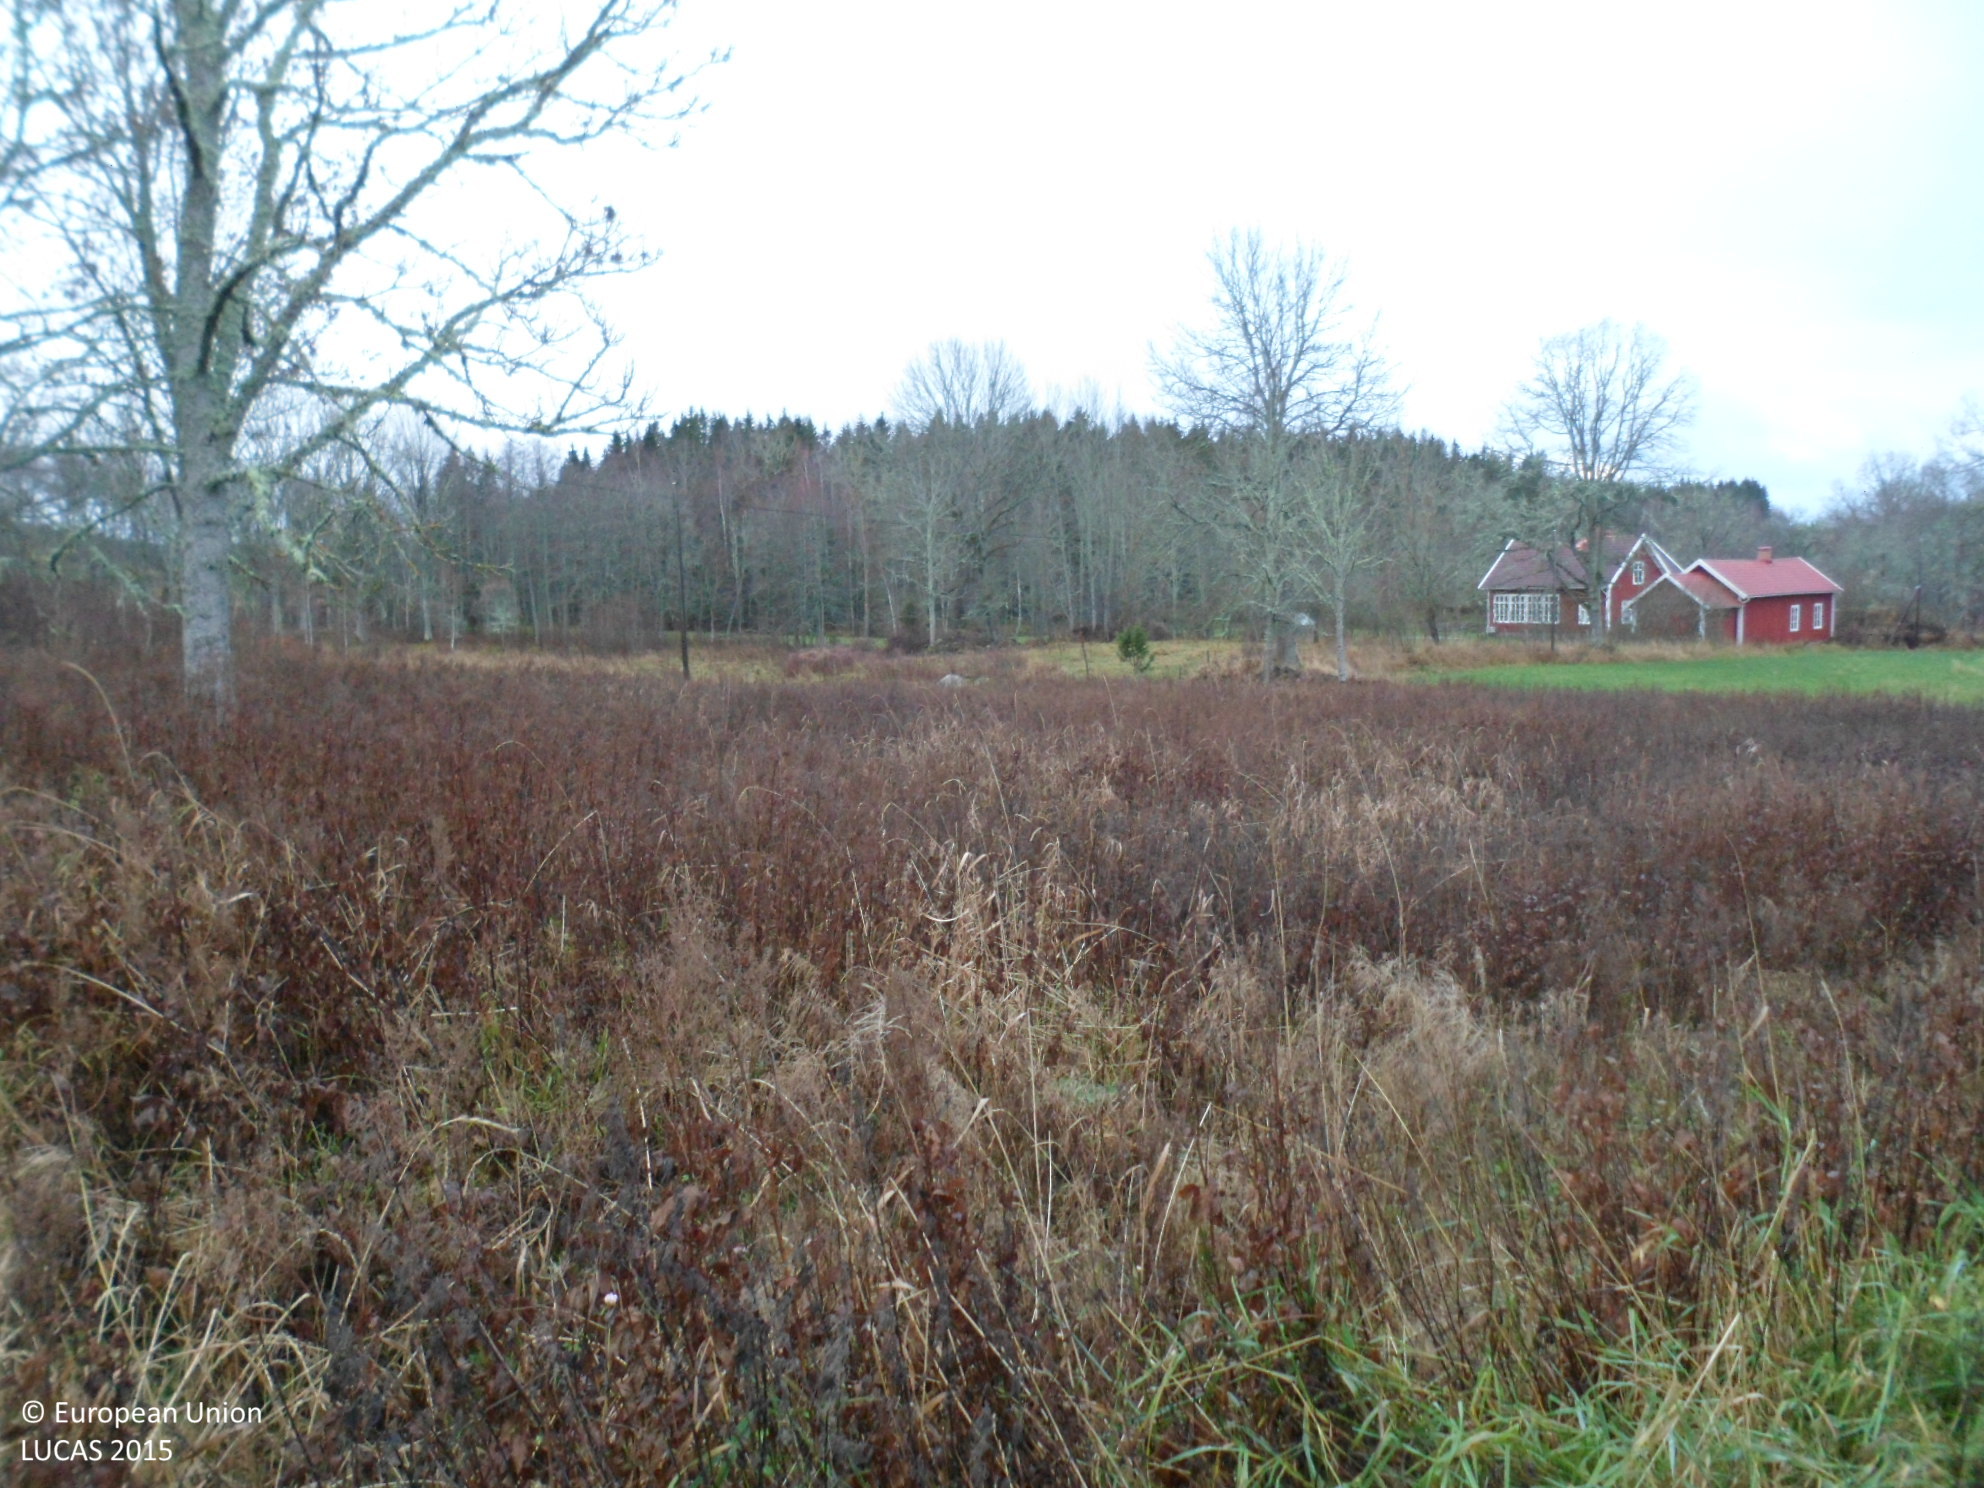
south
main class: Grassland
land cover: Grassland without tree/shrub cover
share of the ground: > 75 %
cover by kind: herbaceous plants 100 %
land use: Agriculture (excluding fallow land and kitchen gardens)
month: November
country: SE
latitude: 57.9783
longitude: 14.6109
